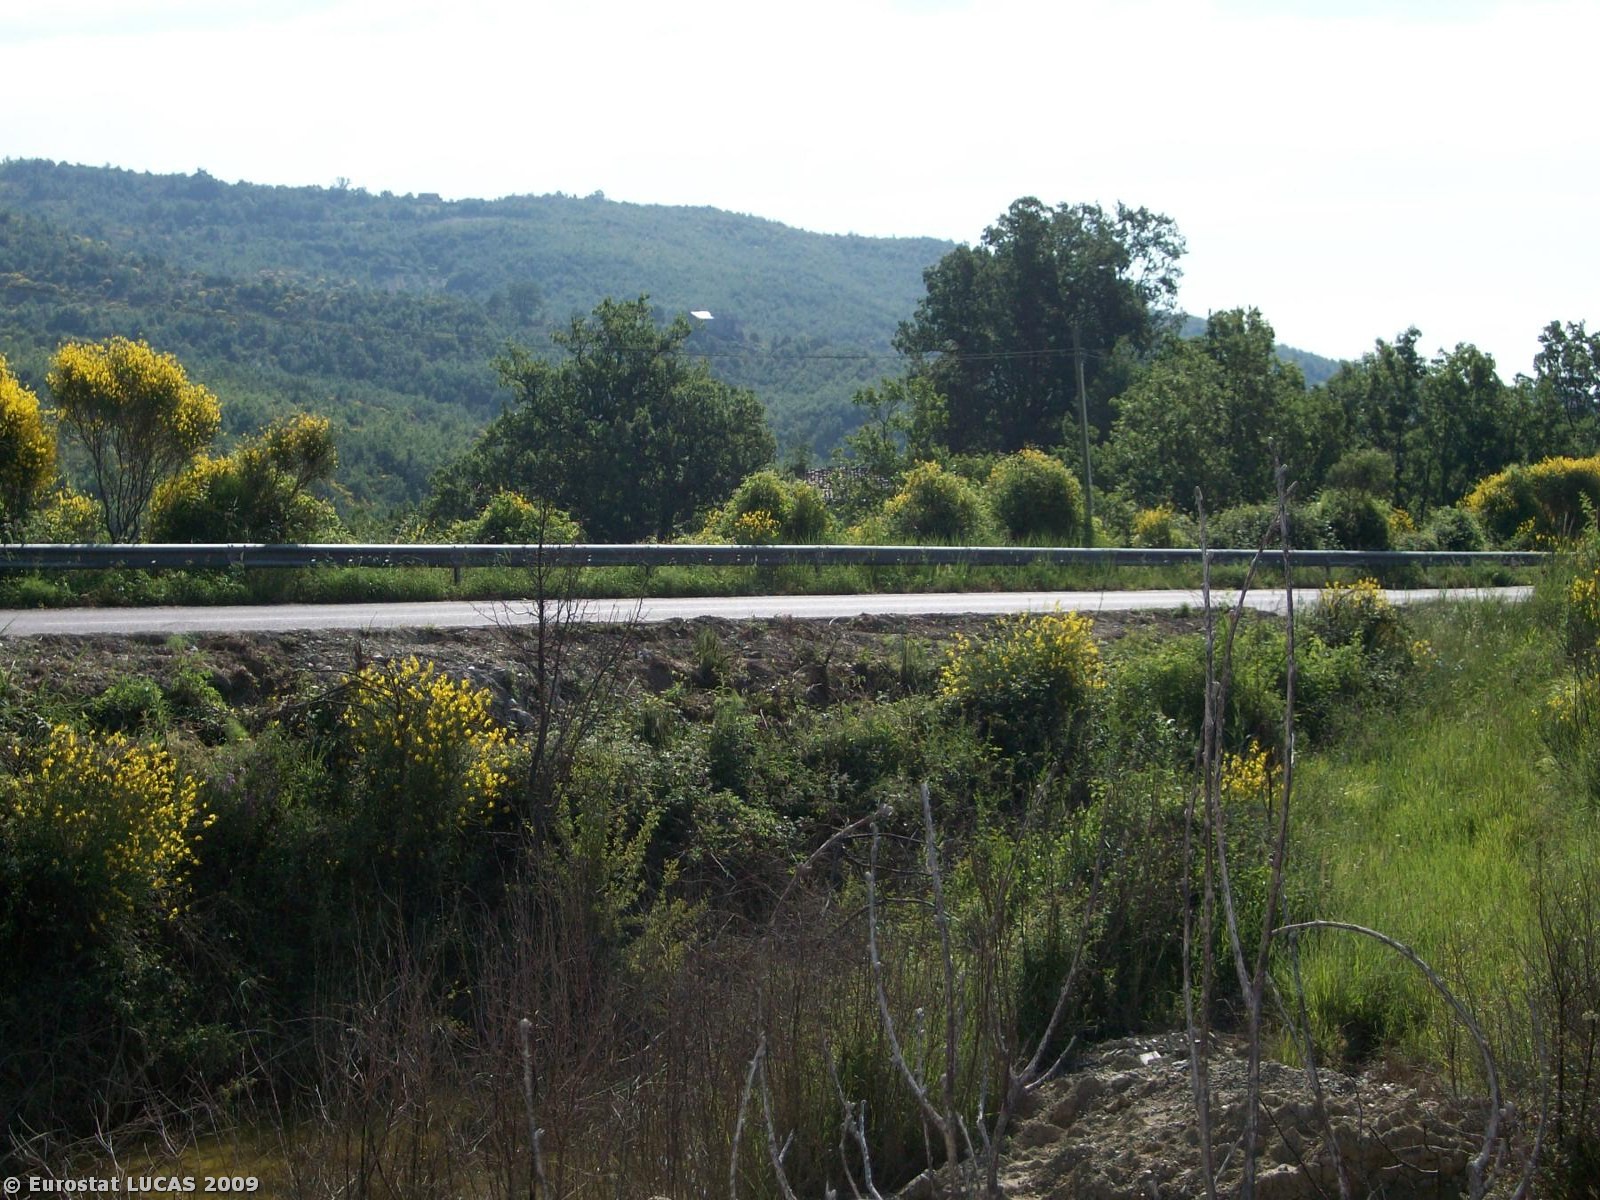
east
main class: Shrubland
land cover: Shrubland without tree cover
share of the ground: > 75 %
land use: Unused
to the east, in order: Shrubland without tree cover; Paved roads, cycling and walking lanes; Shruby margins; Electric lines; Broadleaved woodland
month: June
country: IT
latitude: 39.6980
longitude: 16.0714
